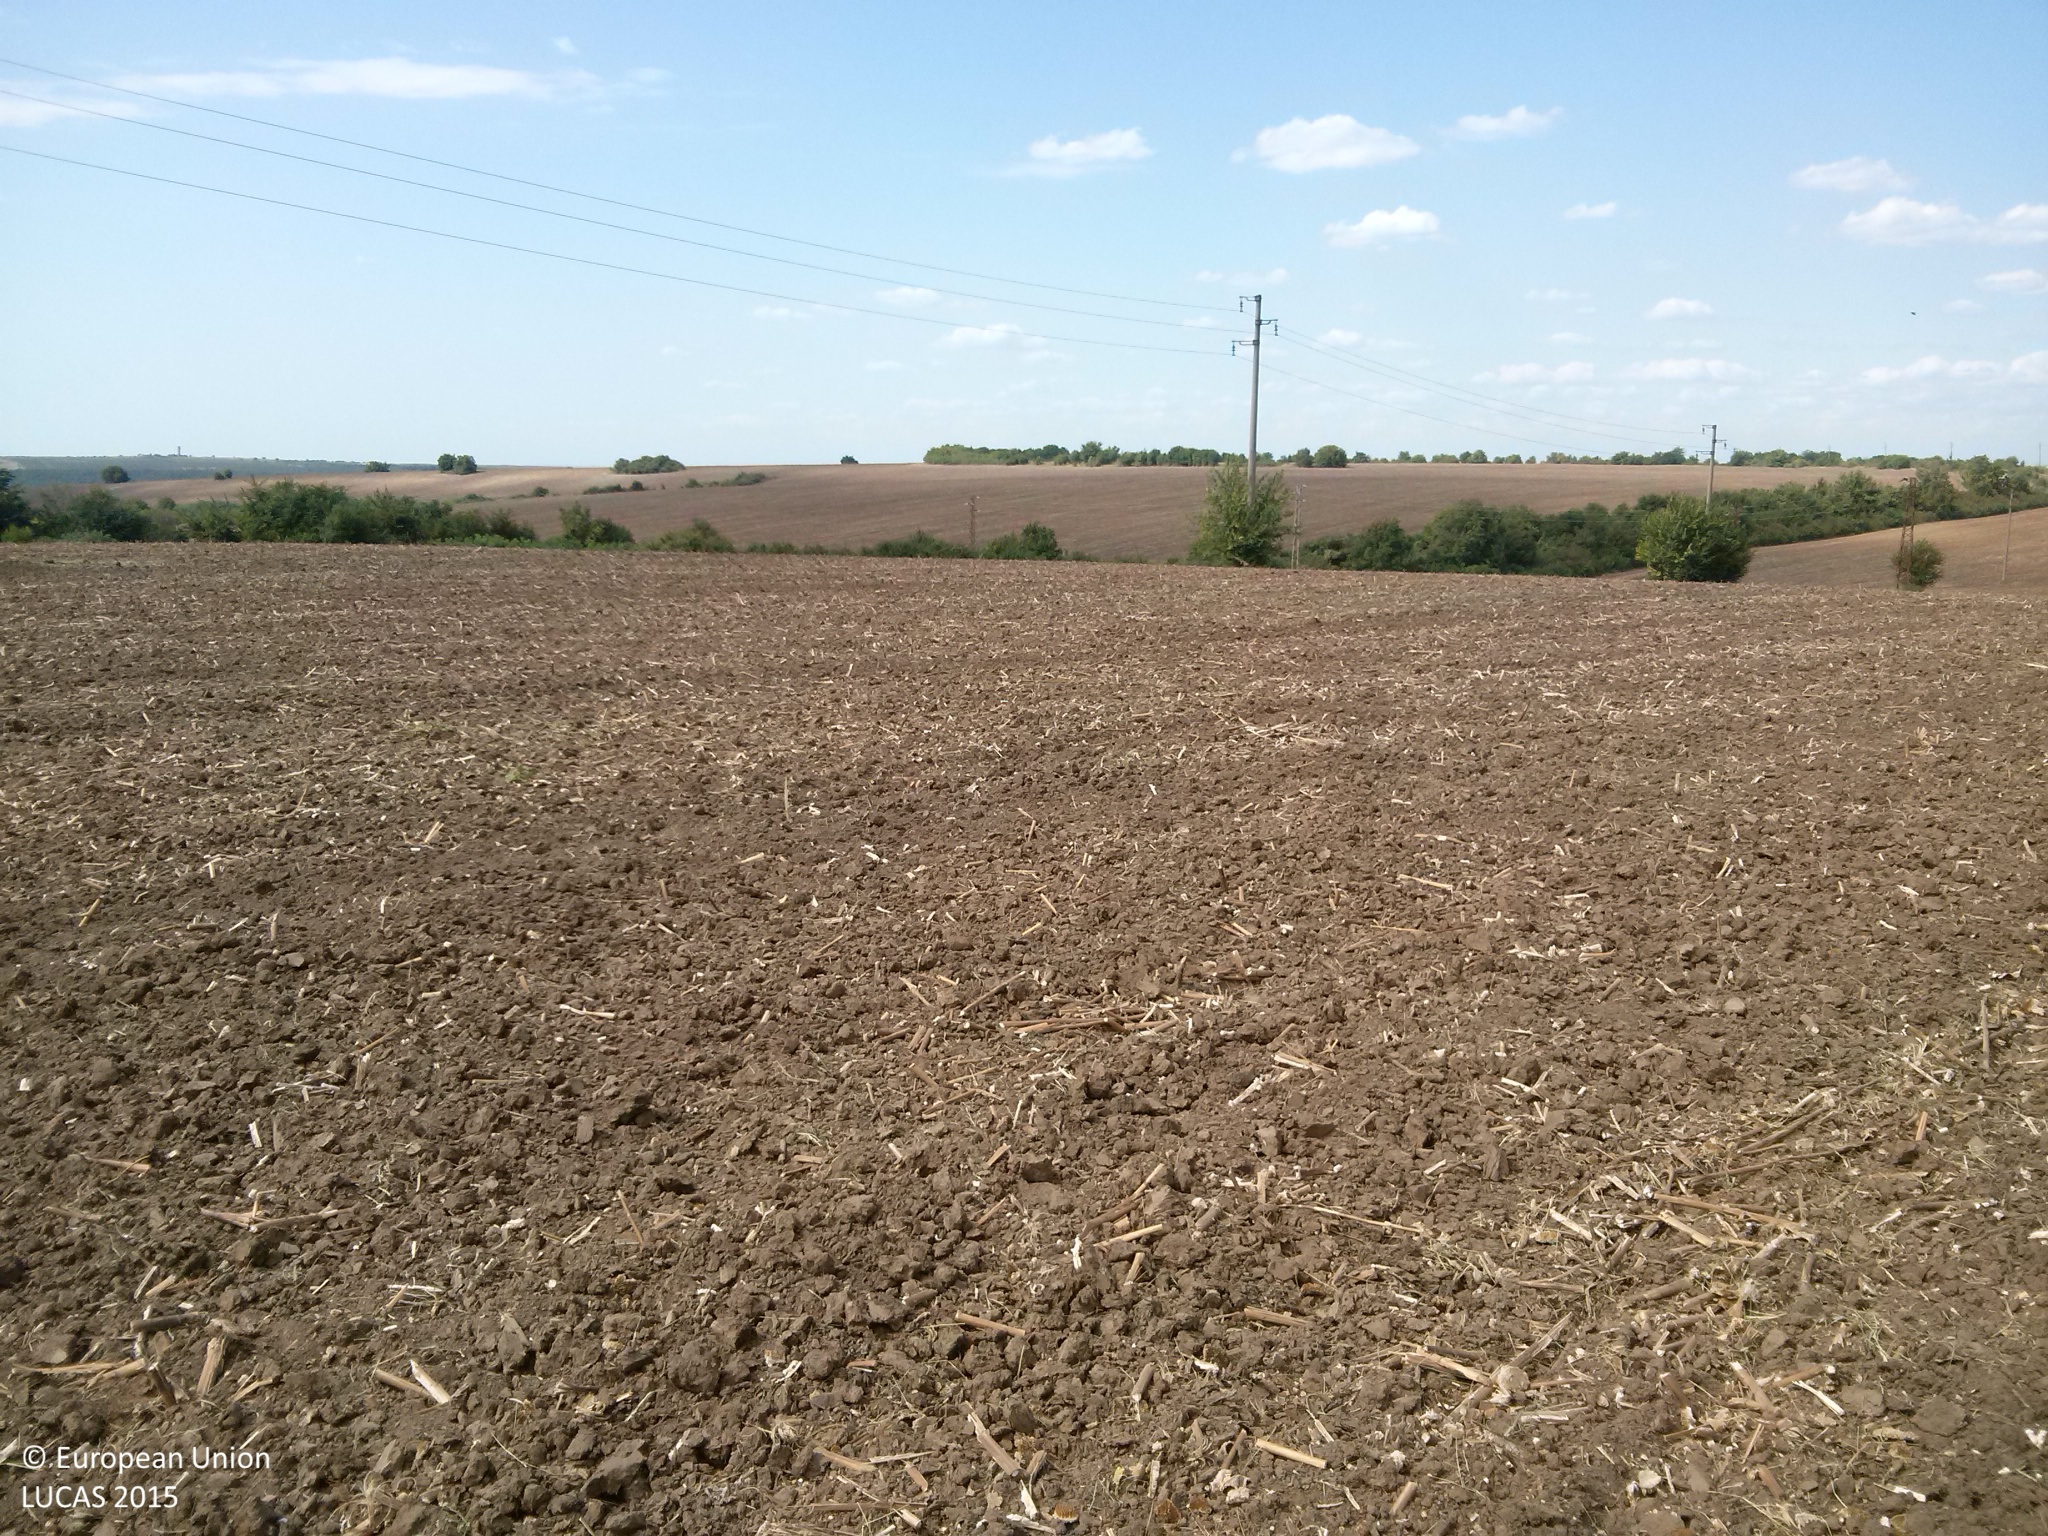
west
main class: Cropland
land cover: Sunflower
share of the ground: < 10 %
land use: Agriculture (excluding fallow land and kitchen gardens)
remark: Harvested field
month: September
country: BG
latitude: 43.8845
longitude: 26.3738
